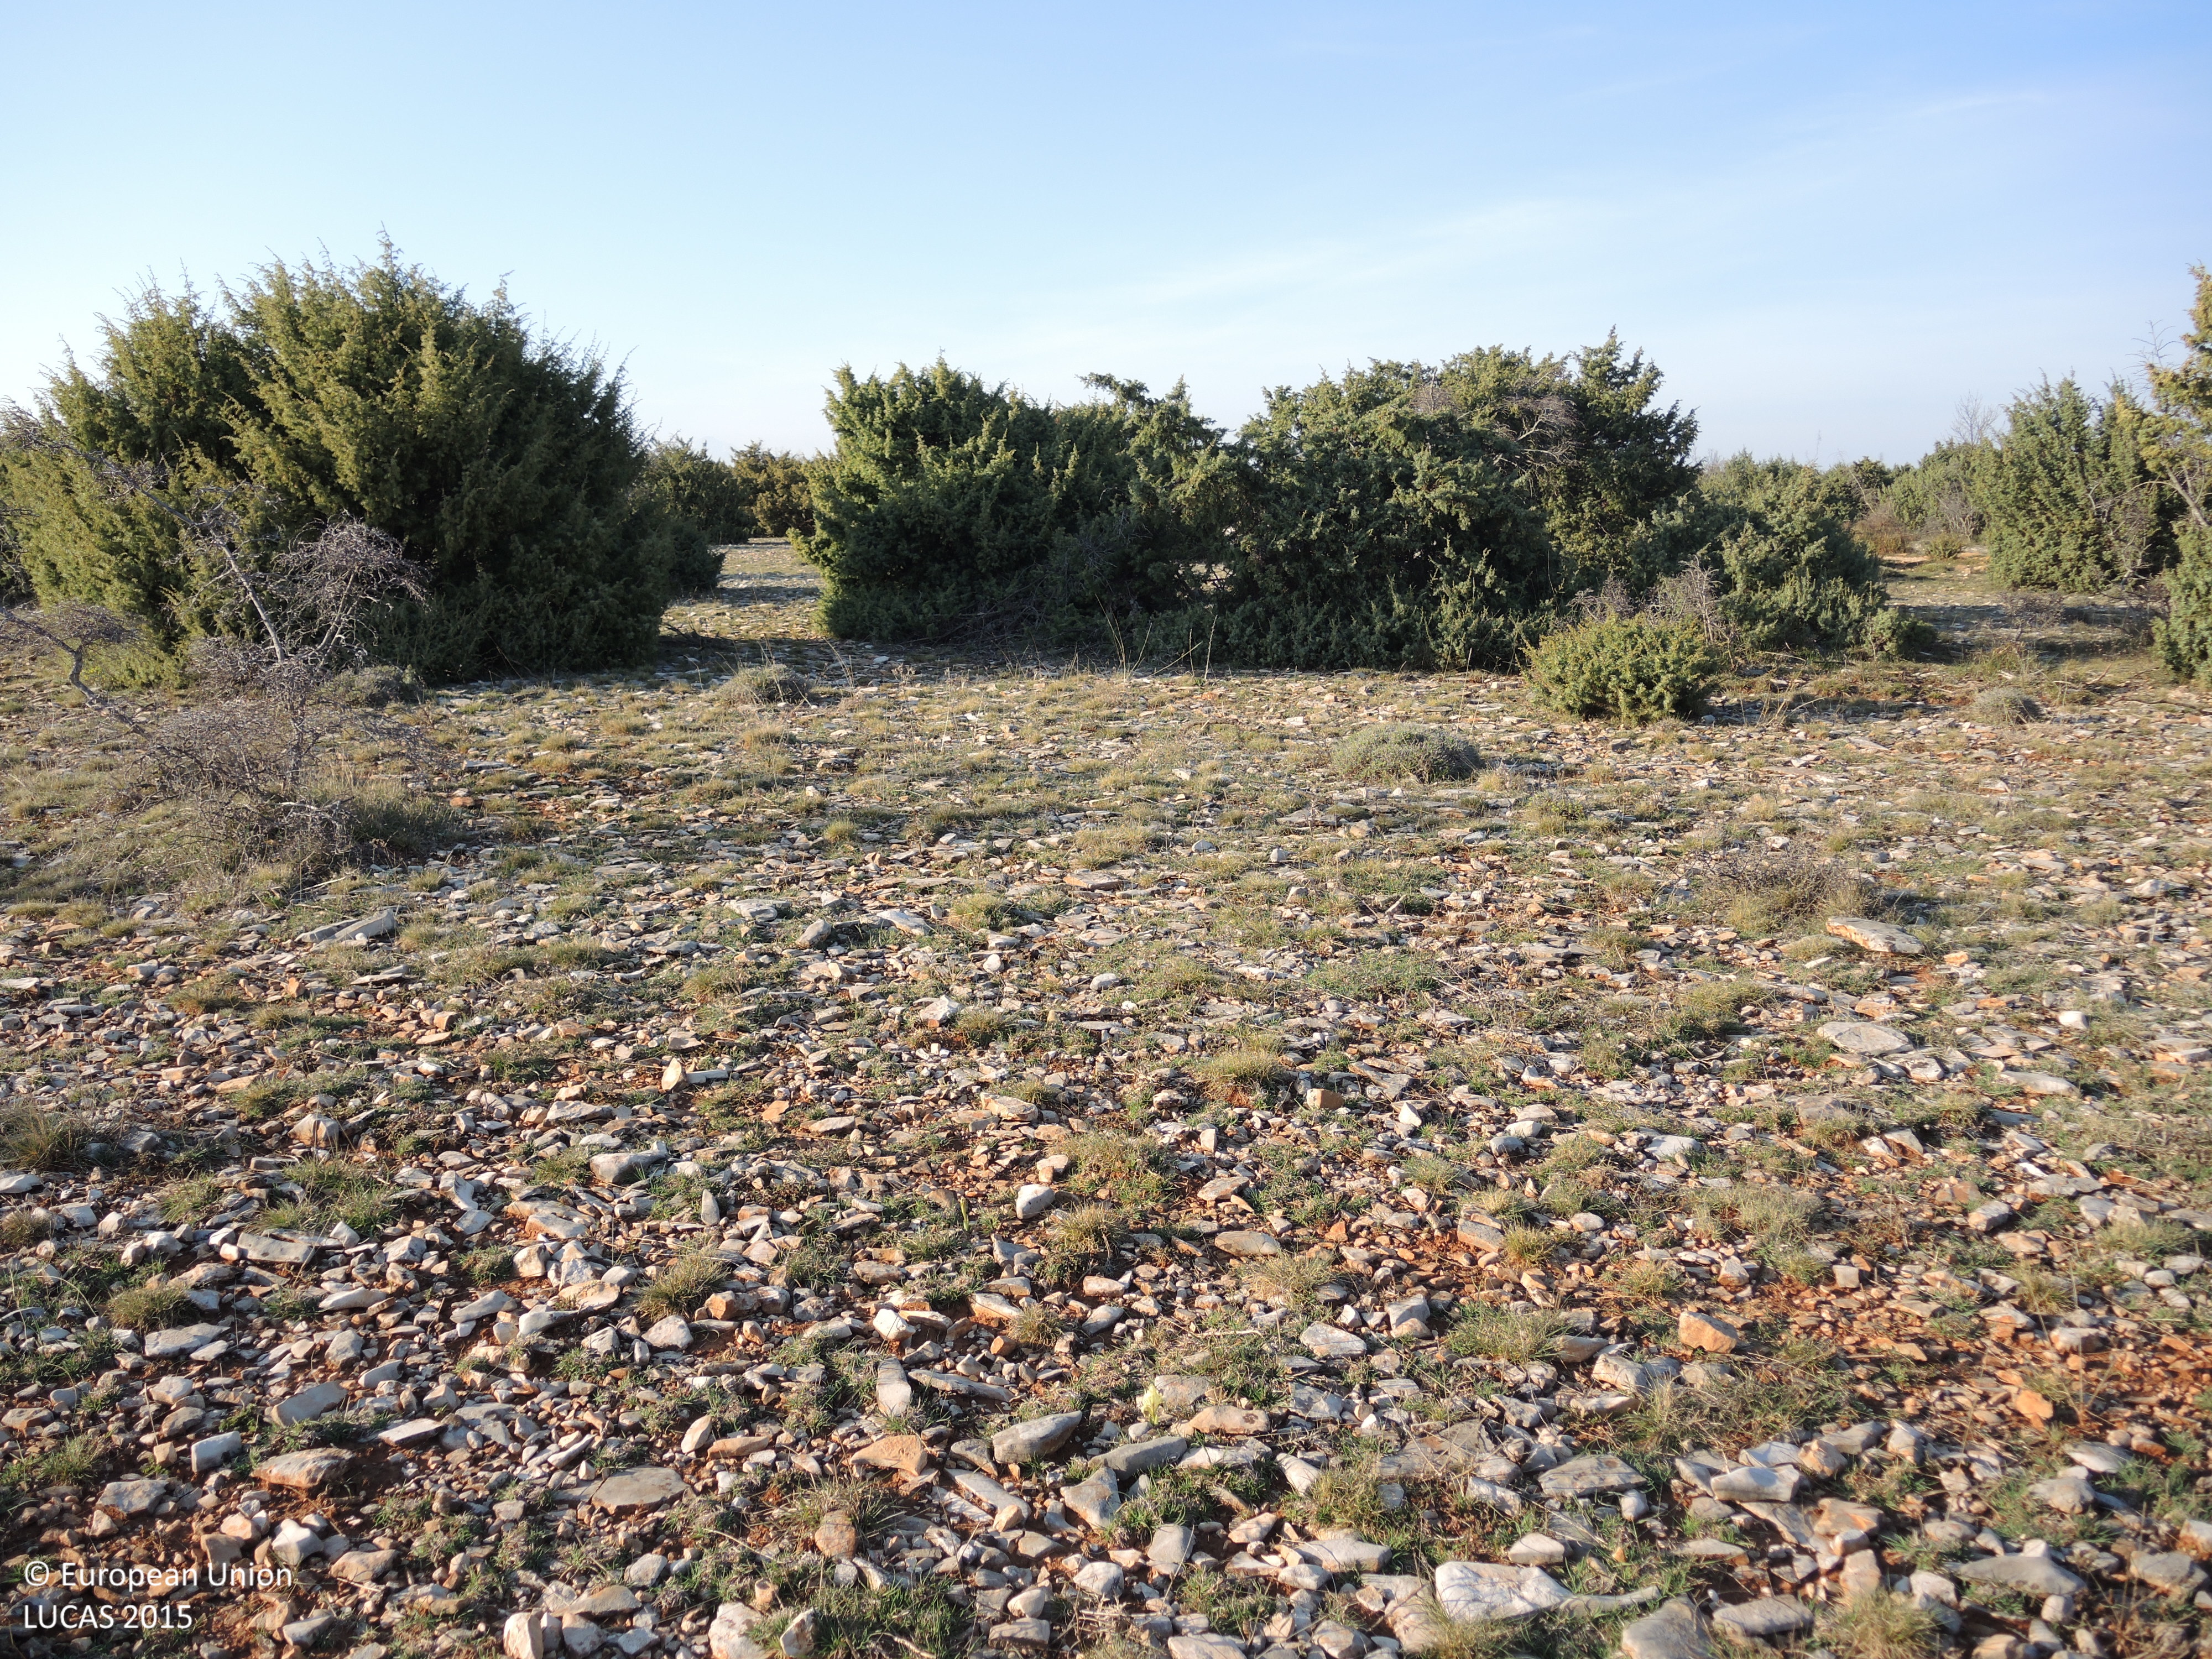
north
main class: Shrubland
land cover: Shrubland with sparse tree cover
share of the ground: 10 - 25 %
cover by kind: unconsolidated bare surface 40 %, shrubs 25 %, herbaceous plants 25 %, broadleaved forest trees 5 %, consolidated bare surface 5 %
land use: Semi-natural and natural areas not in use
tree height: < 5 m
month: April
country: HR
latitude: 44.0536
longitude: 15.6214
